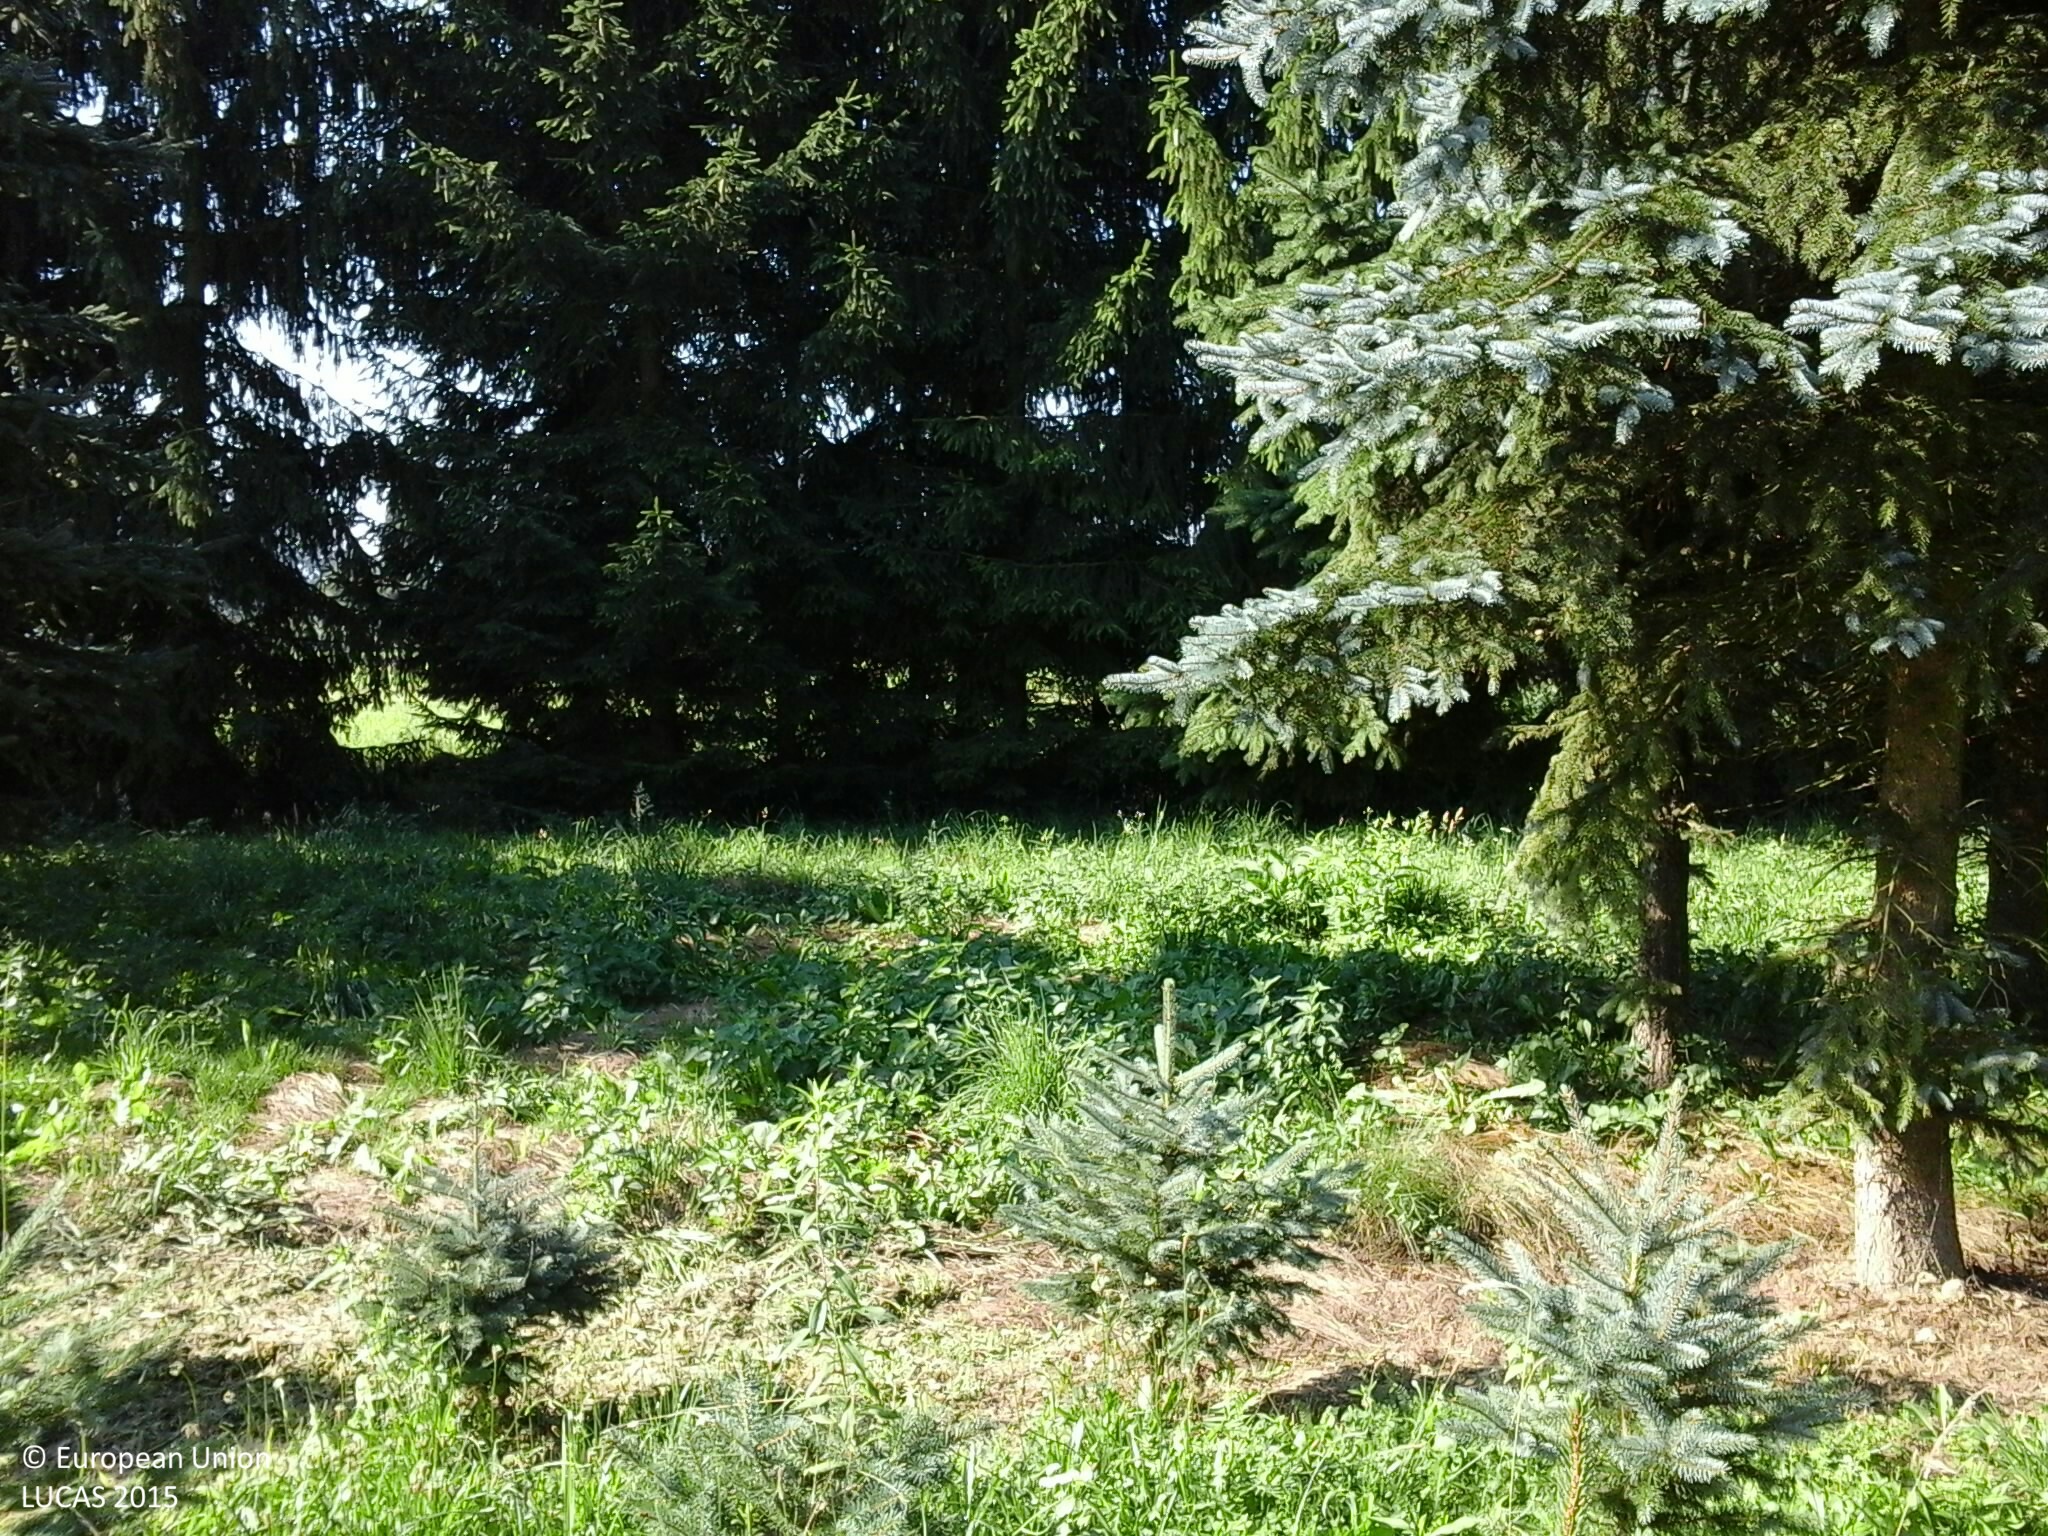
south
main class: Cropland
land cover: Nurseries
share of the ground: 25 - 50 %
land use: Forestry
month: July
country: HU
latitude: 46.9721
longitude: 16.4034
